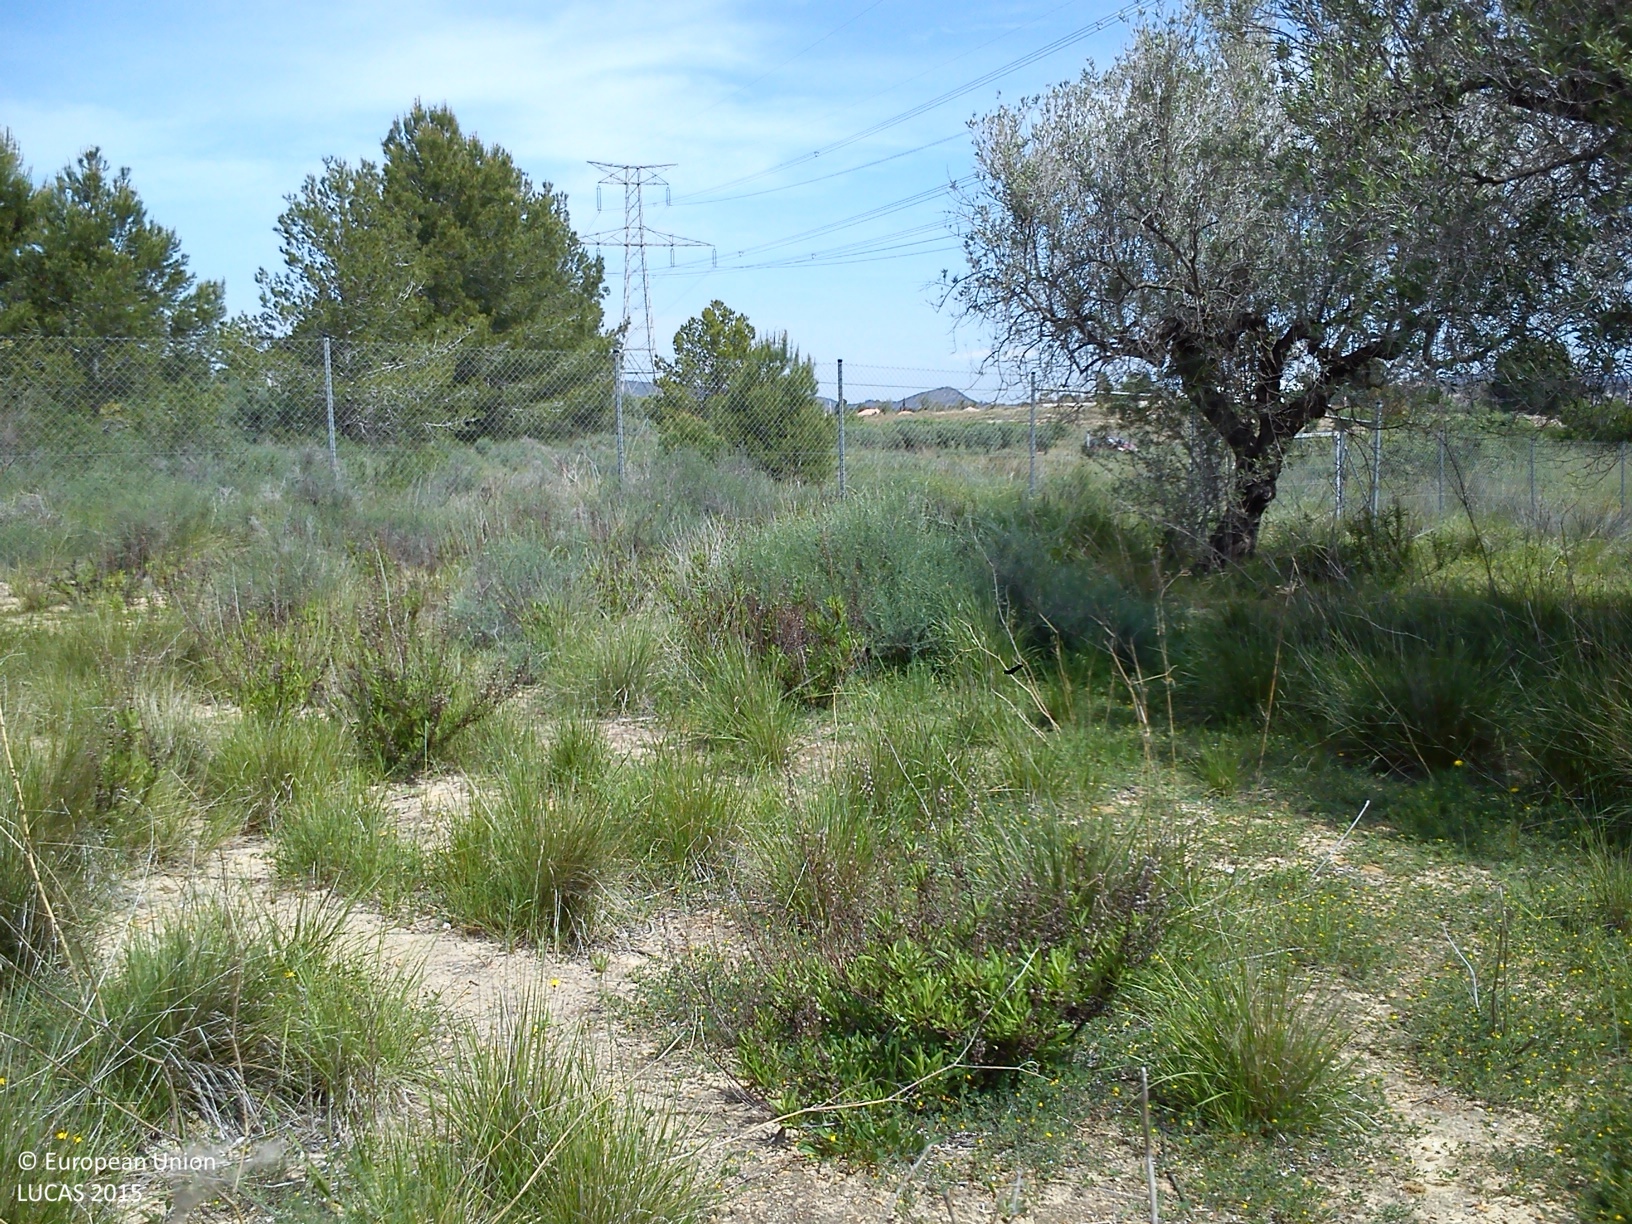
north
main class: Cropland
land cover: Olive groves
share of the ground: 25 - 50 %
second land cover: Spontaneously vegetated surfaces
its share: > 75 %
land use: Agriculture (excluding fallow land and kitchen gardens)
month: April
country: ES
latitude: 39.3229
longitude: -0.6337
